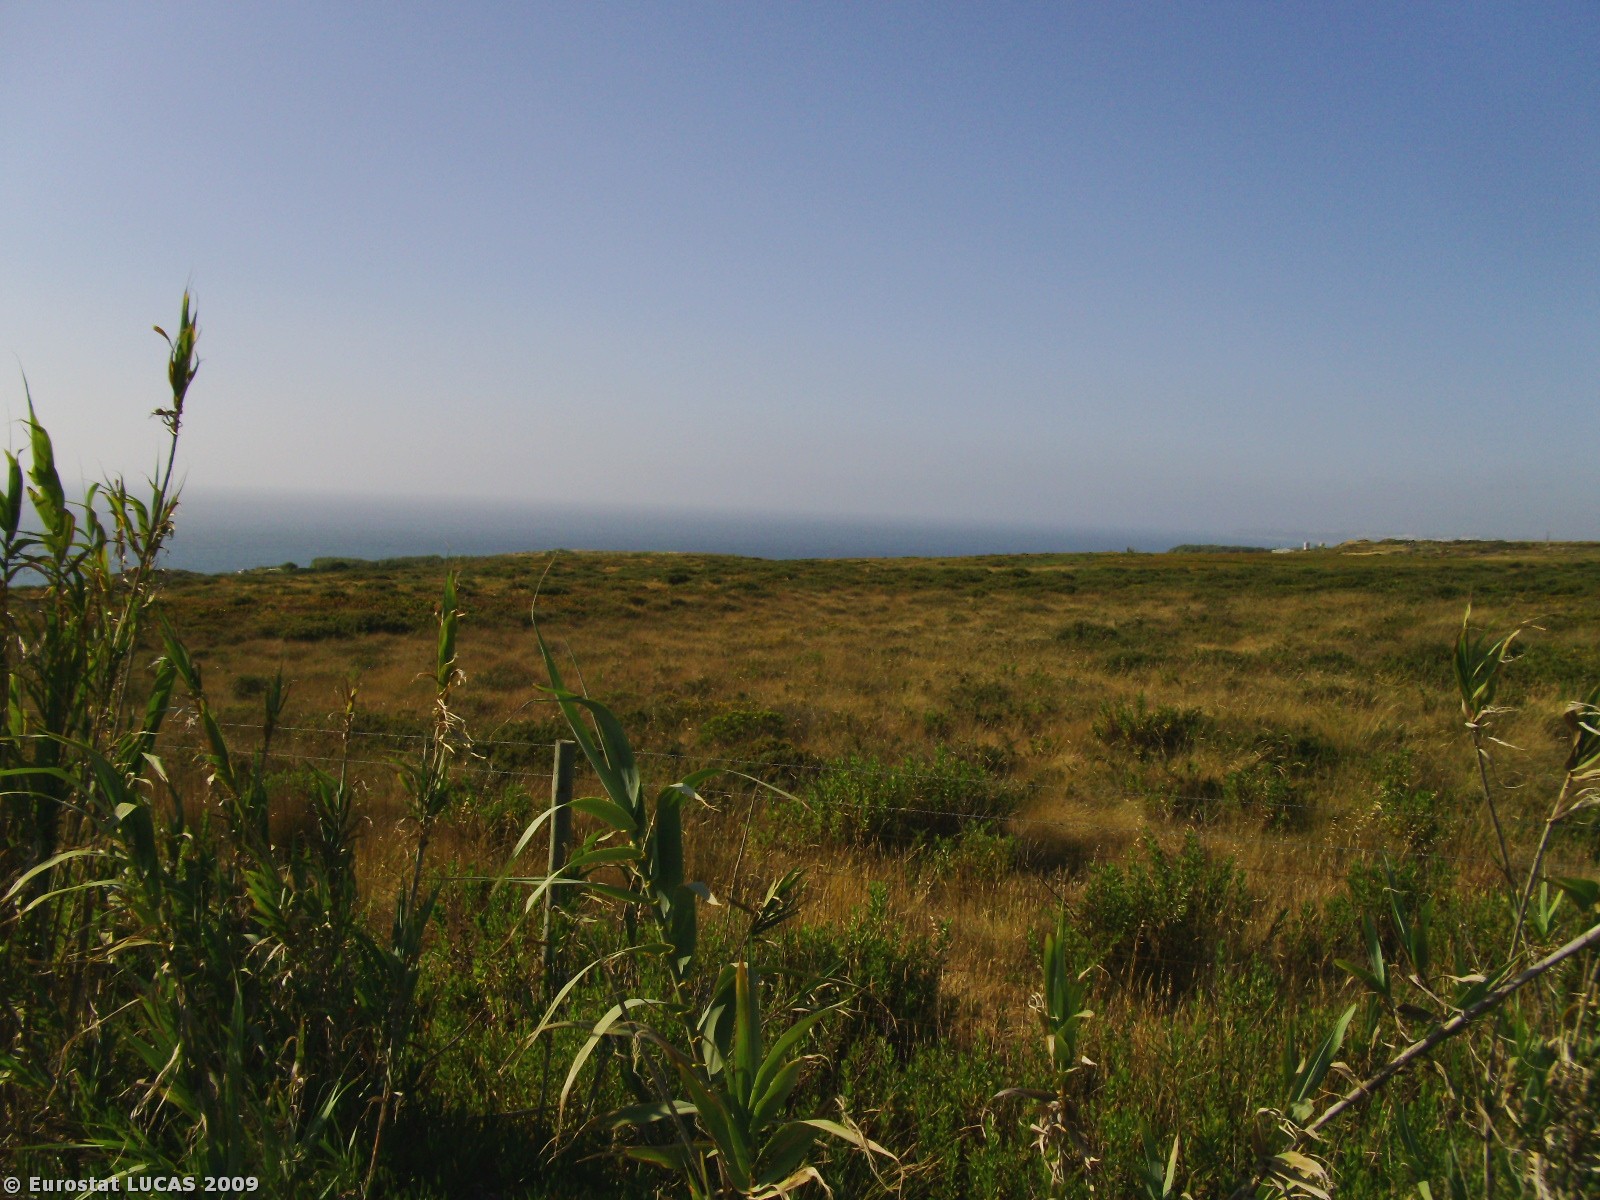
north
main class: Grassland
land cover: Spontaneously vegetated surfaces
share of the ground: > 75 %
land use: Nature reserves
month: July
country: PT
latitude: 38.8764
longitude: -9.4405
